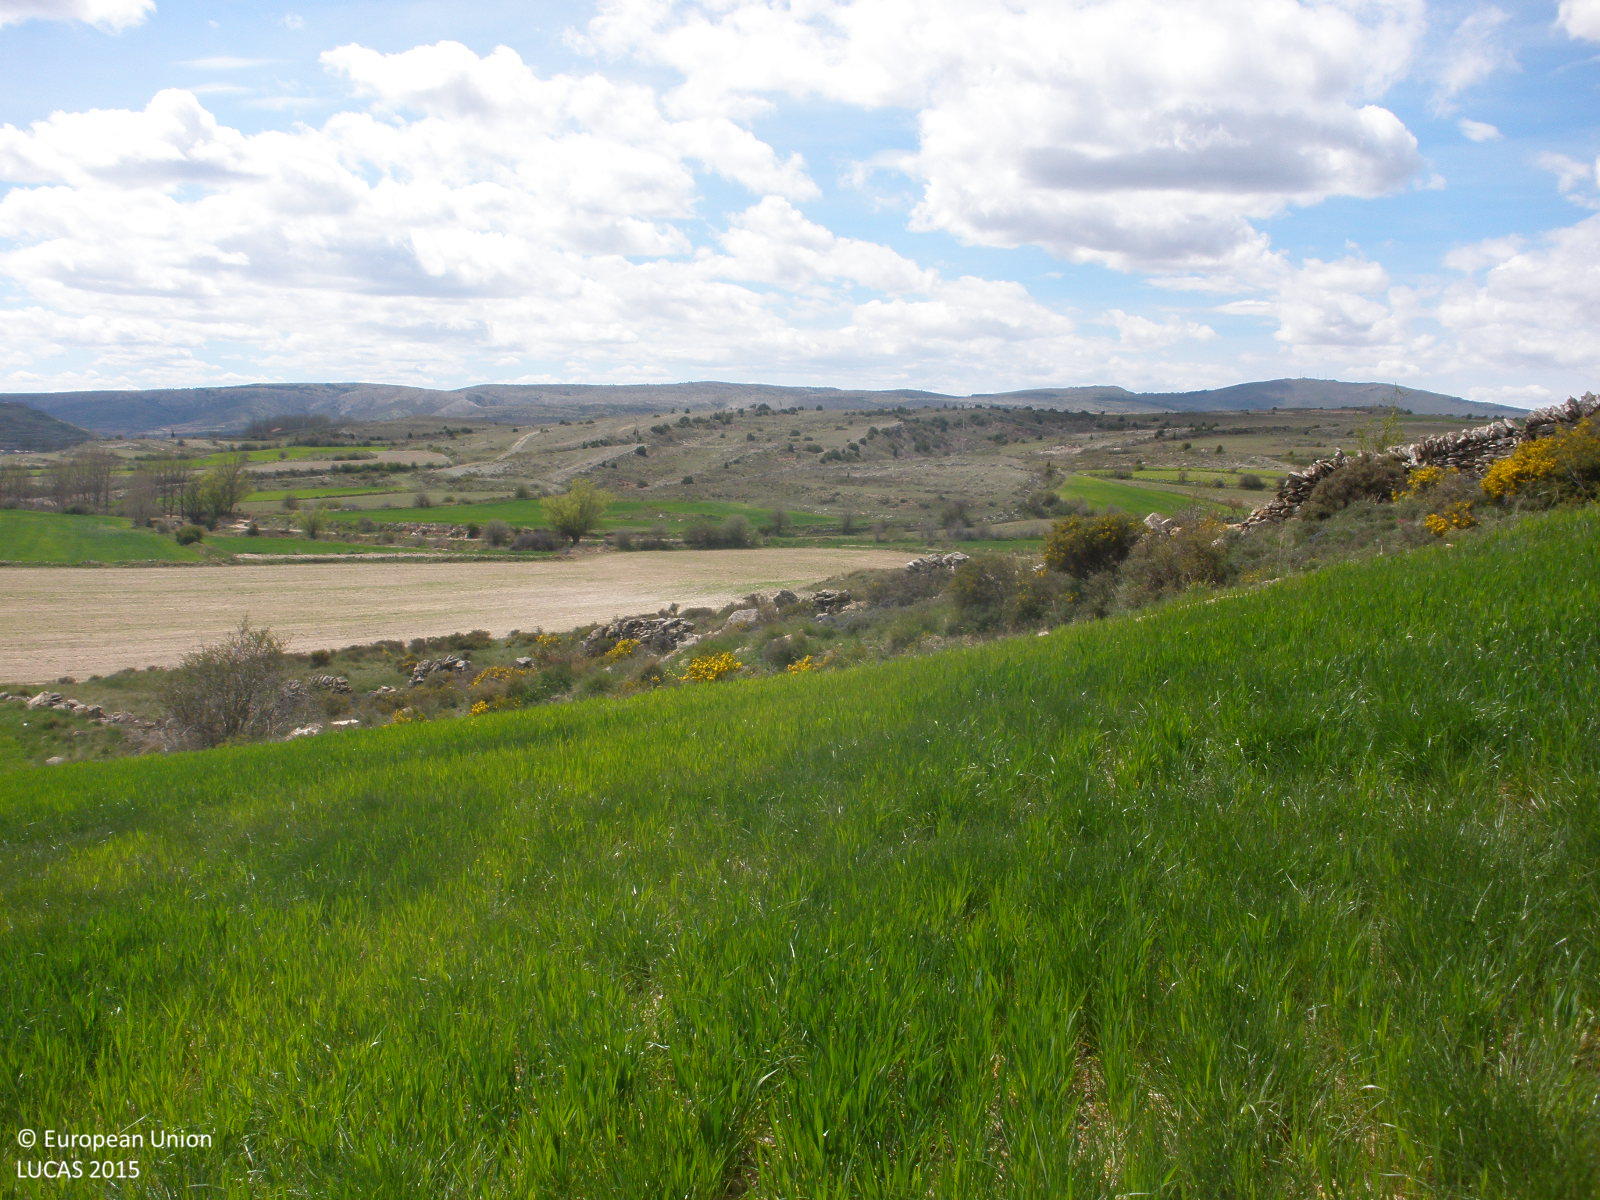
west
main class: Cropland
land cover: Barley
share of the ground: > 75 %
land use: Agriculture (excluding fallow land and kitchen gardens)
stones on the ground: 10 - 25 %
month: April
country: ES
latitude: 40.4510
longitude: -0.8223
